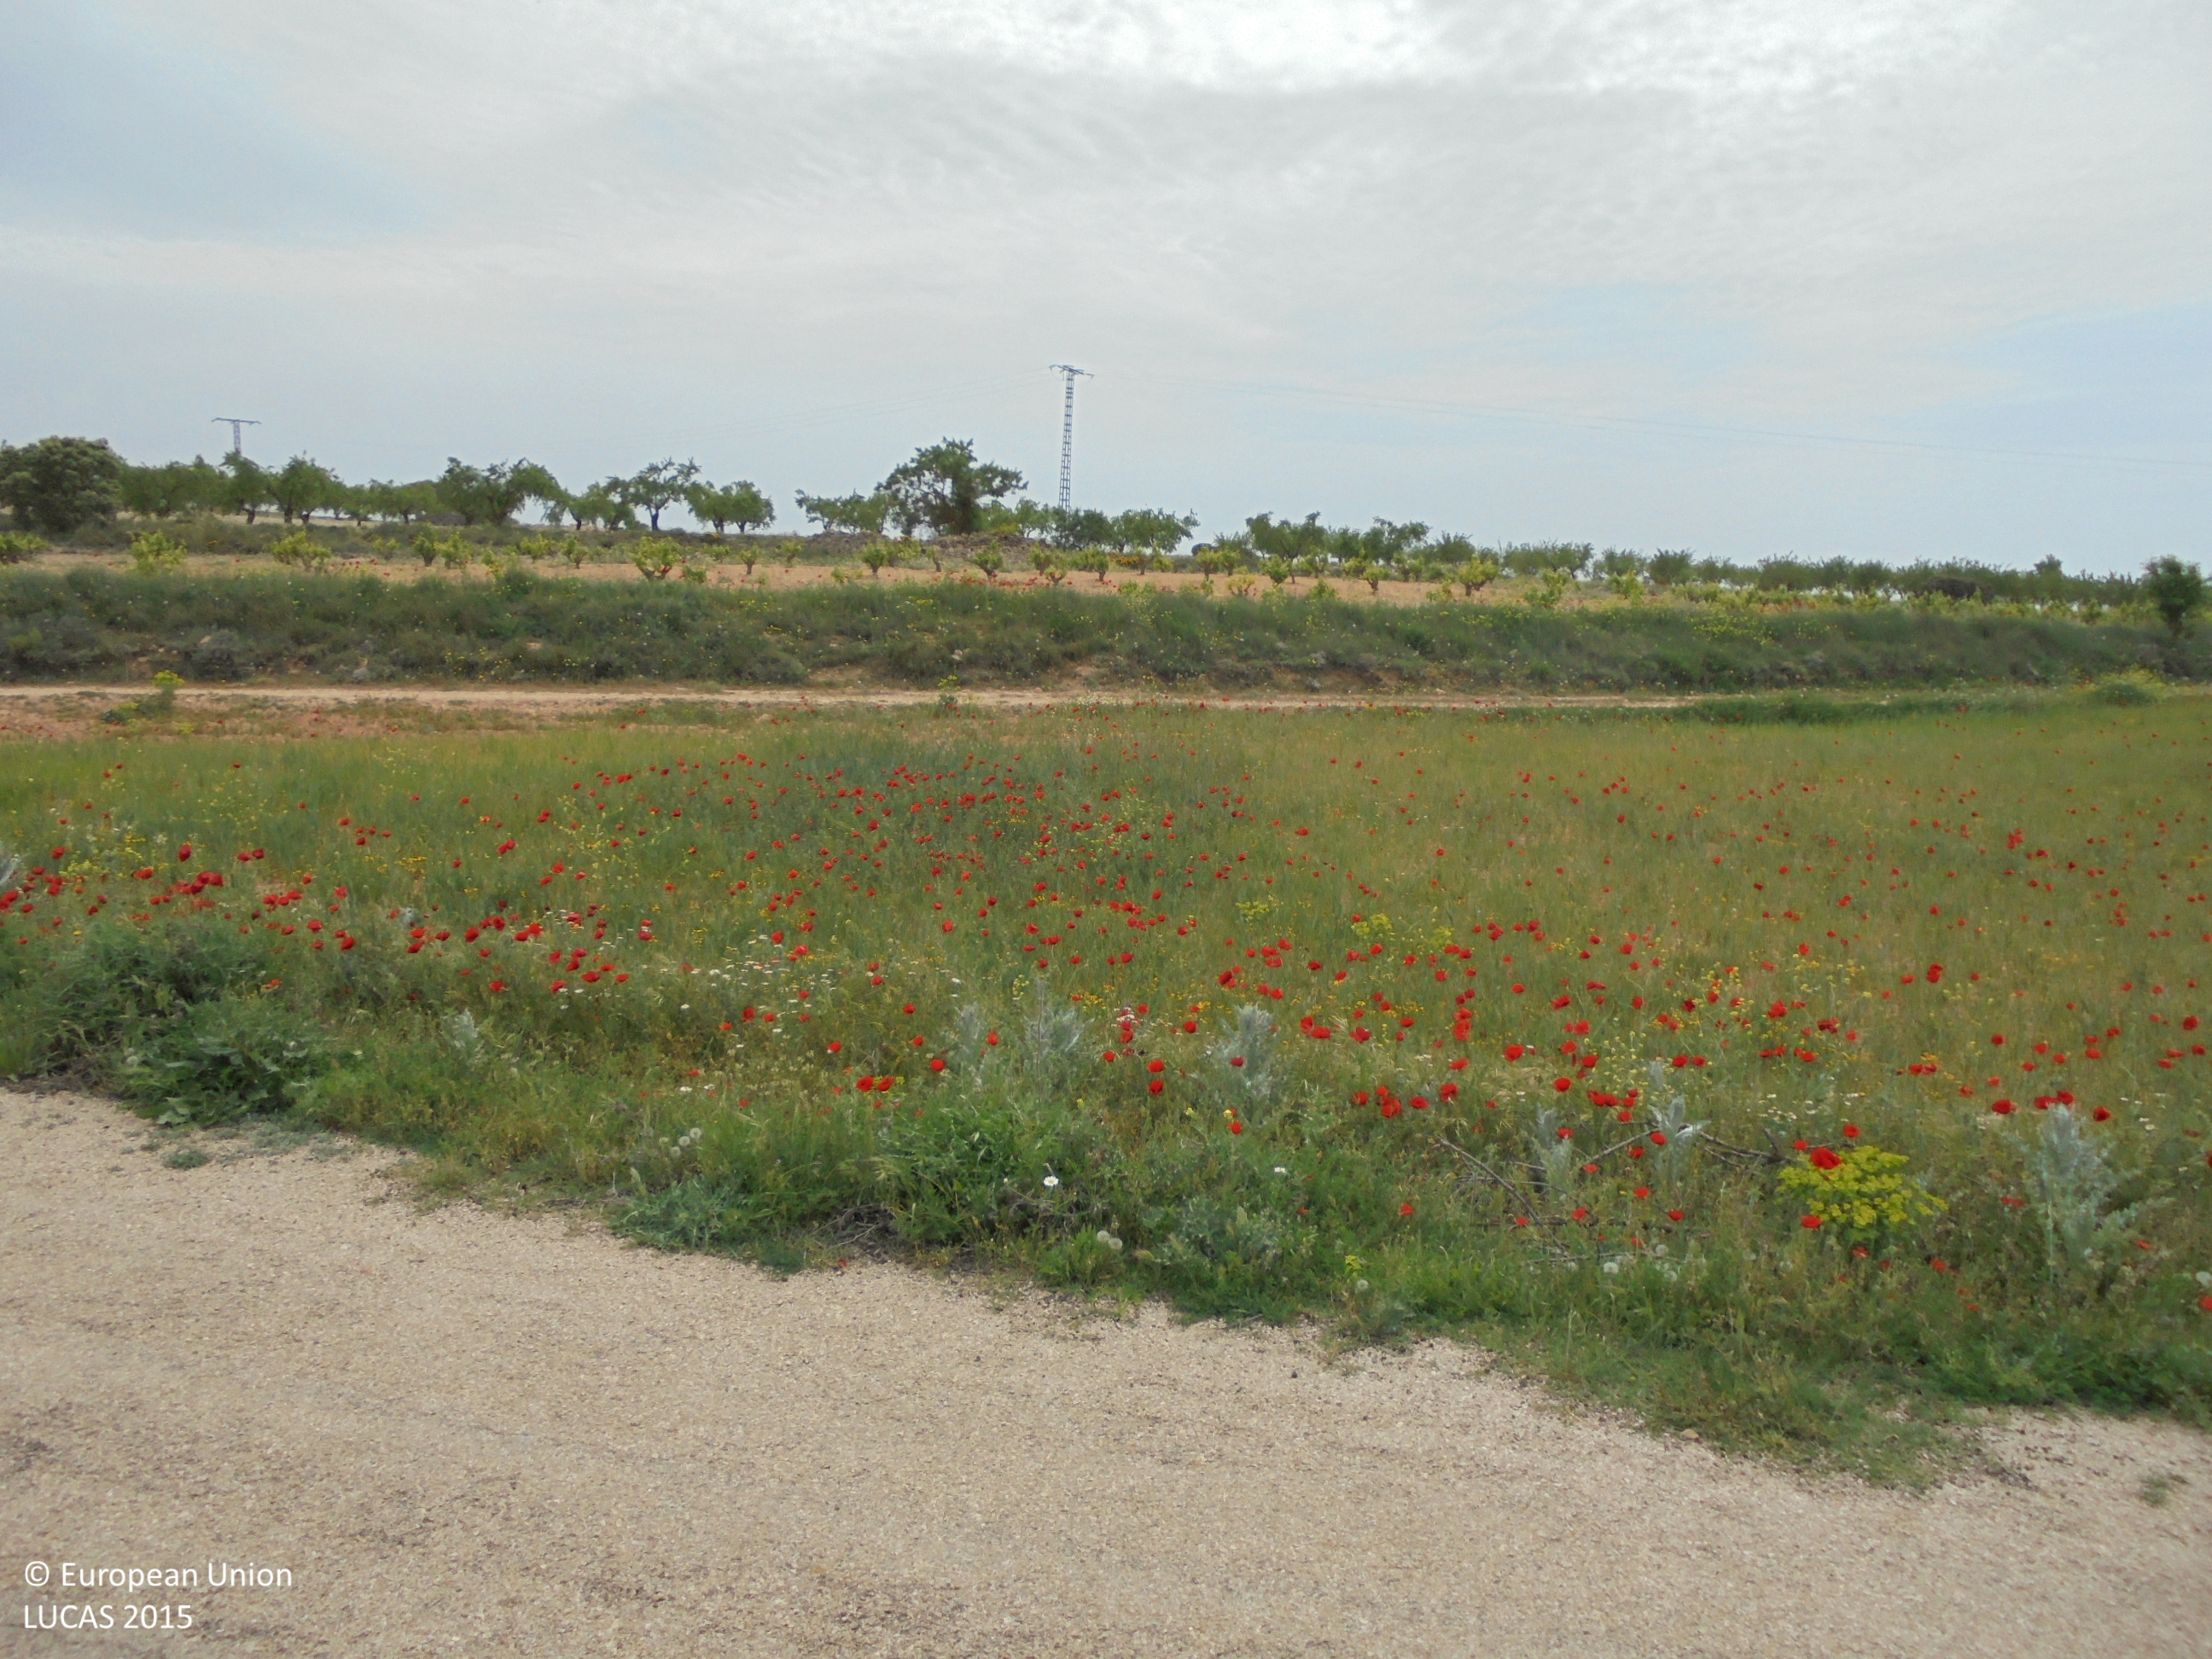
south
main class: Cropland
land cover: Barley
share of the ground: 25 - 50 %
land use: Agriculture (excluding fallow land and kitchen gardens)
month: May
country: ES
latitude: 39.2424
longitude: -1.6462
